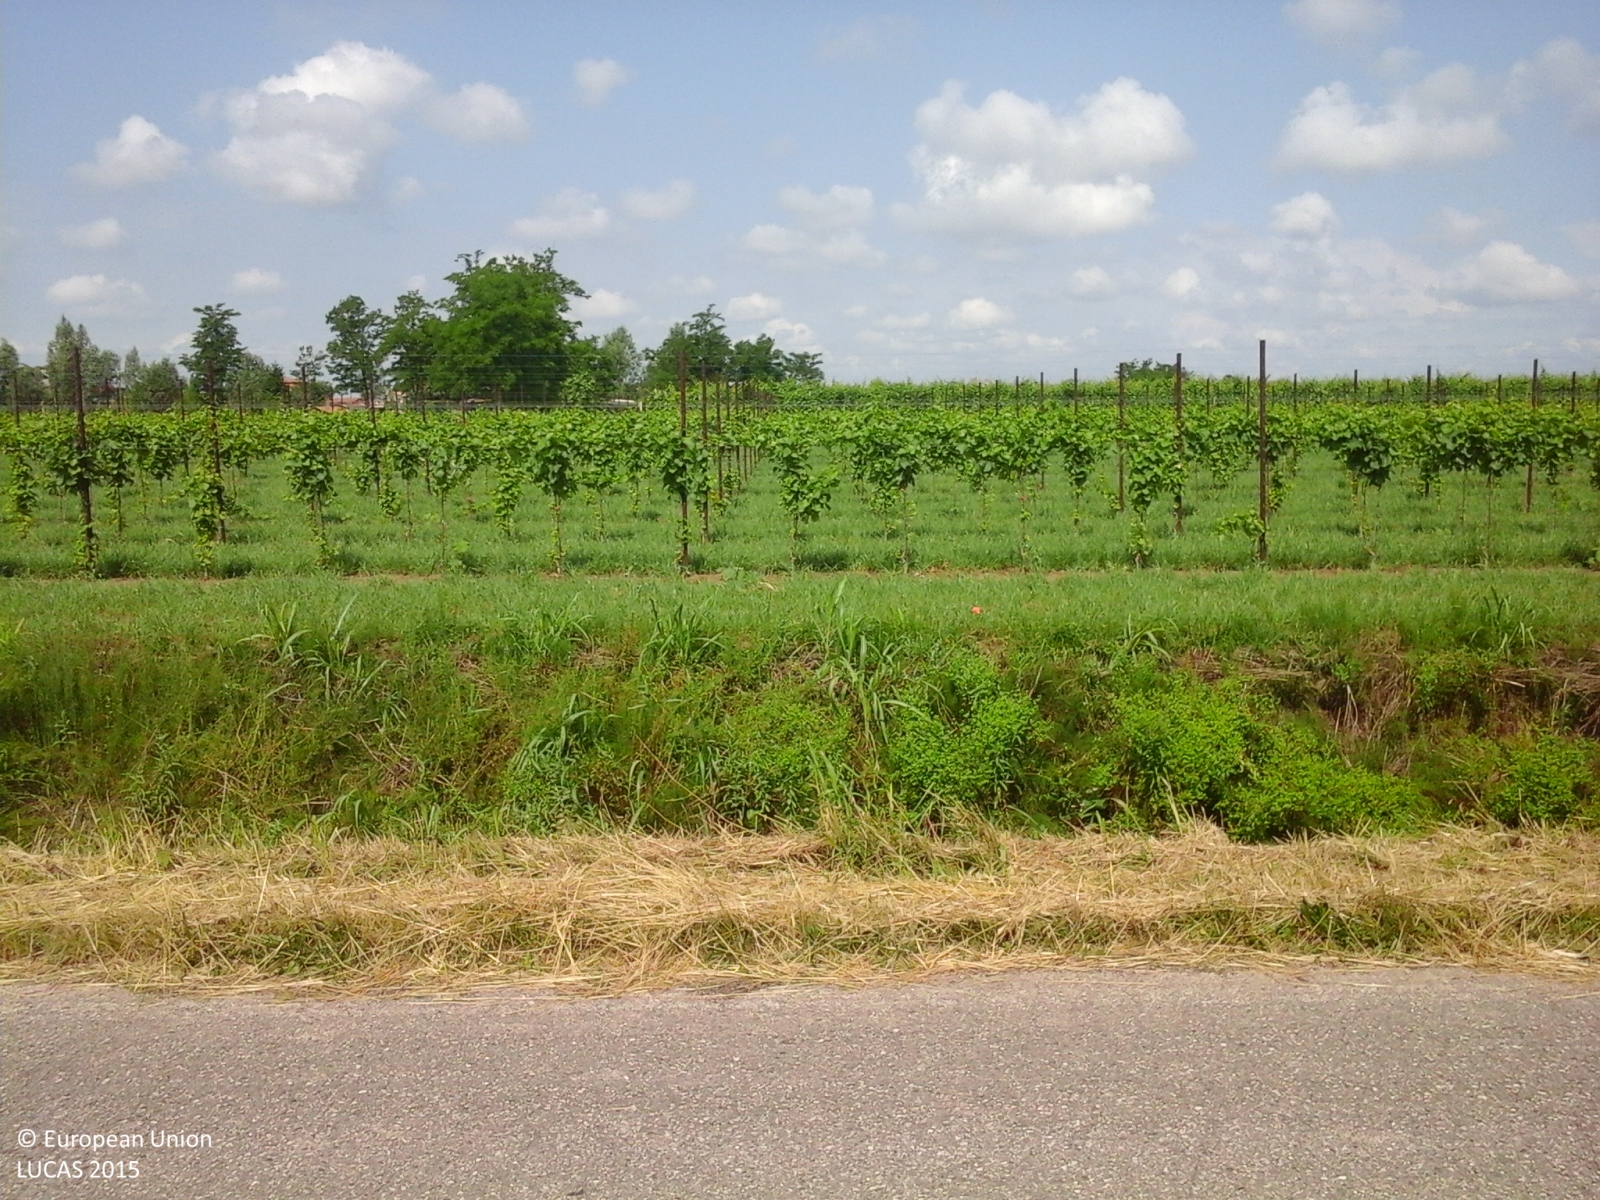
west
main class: Cropland
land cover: Maize
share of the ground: > 75 %
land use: Agriculture (excluding fallow land and kitchen gardens)
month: June
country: IT
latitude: 45.5967
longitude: 12.6755
